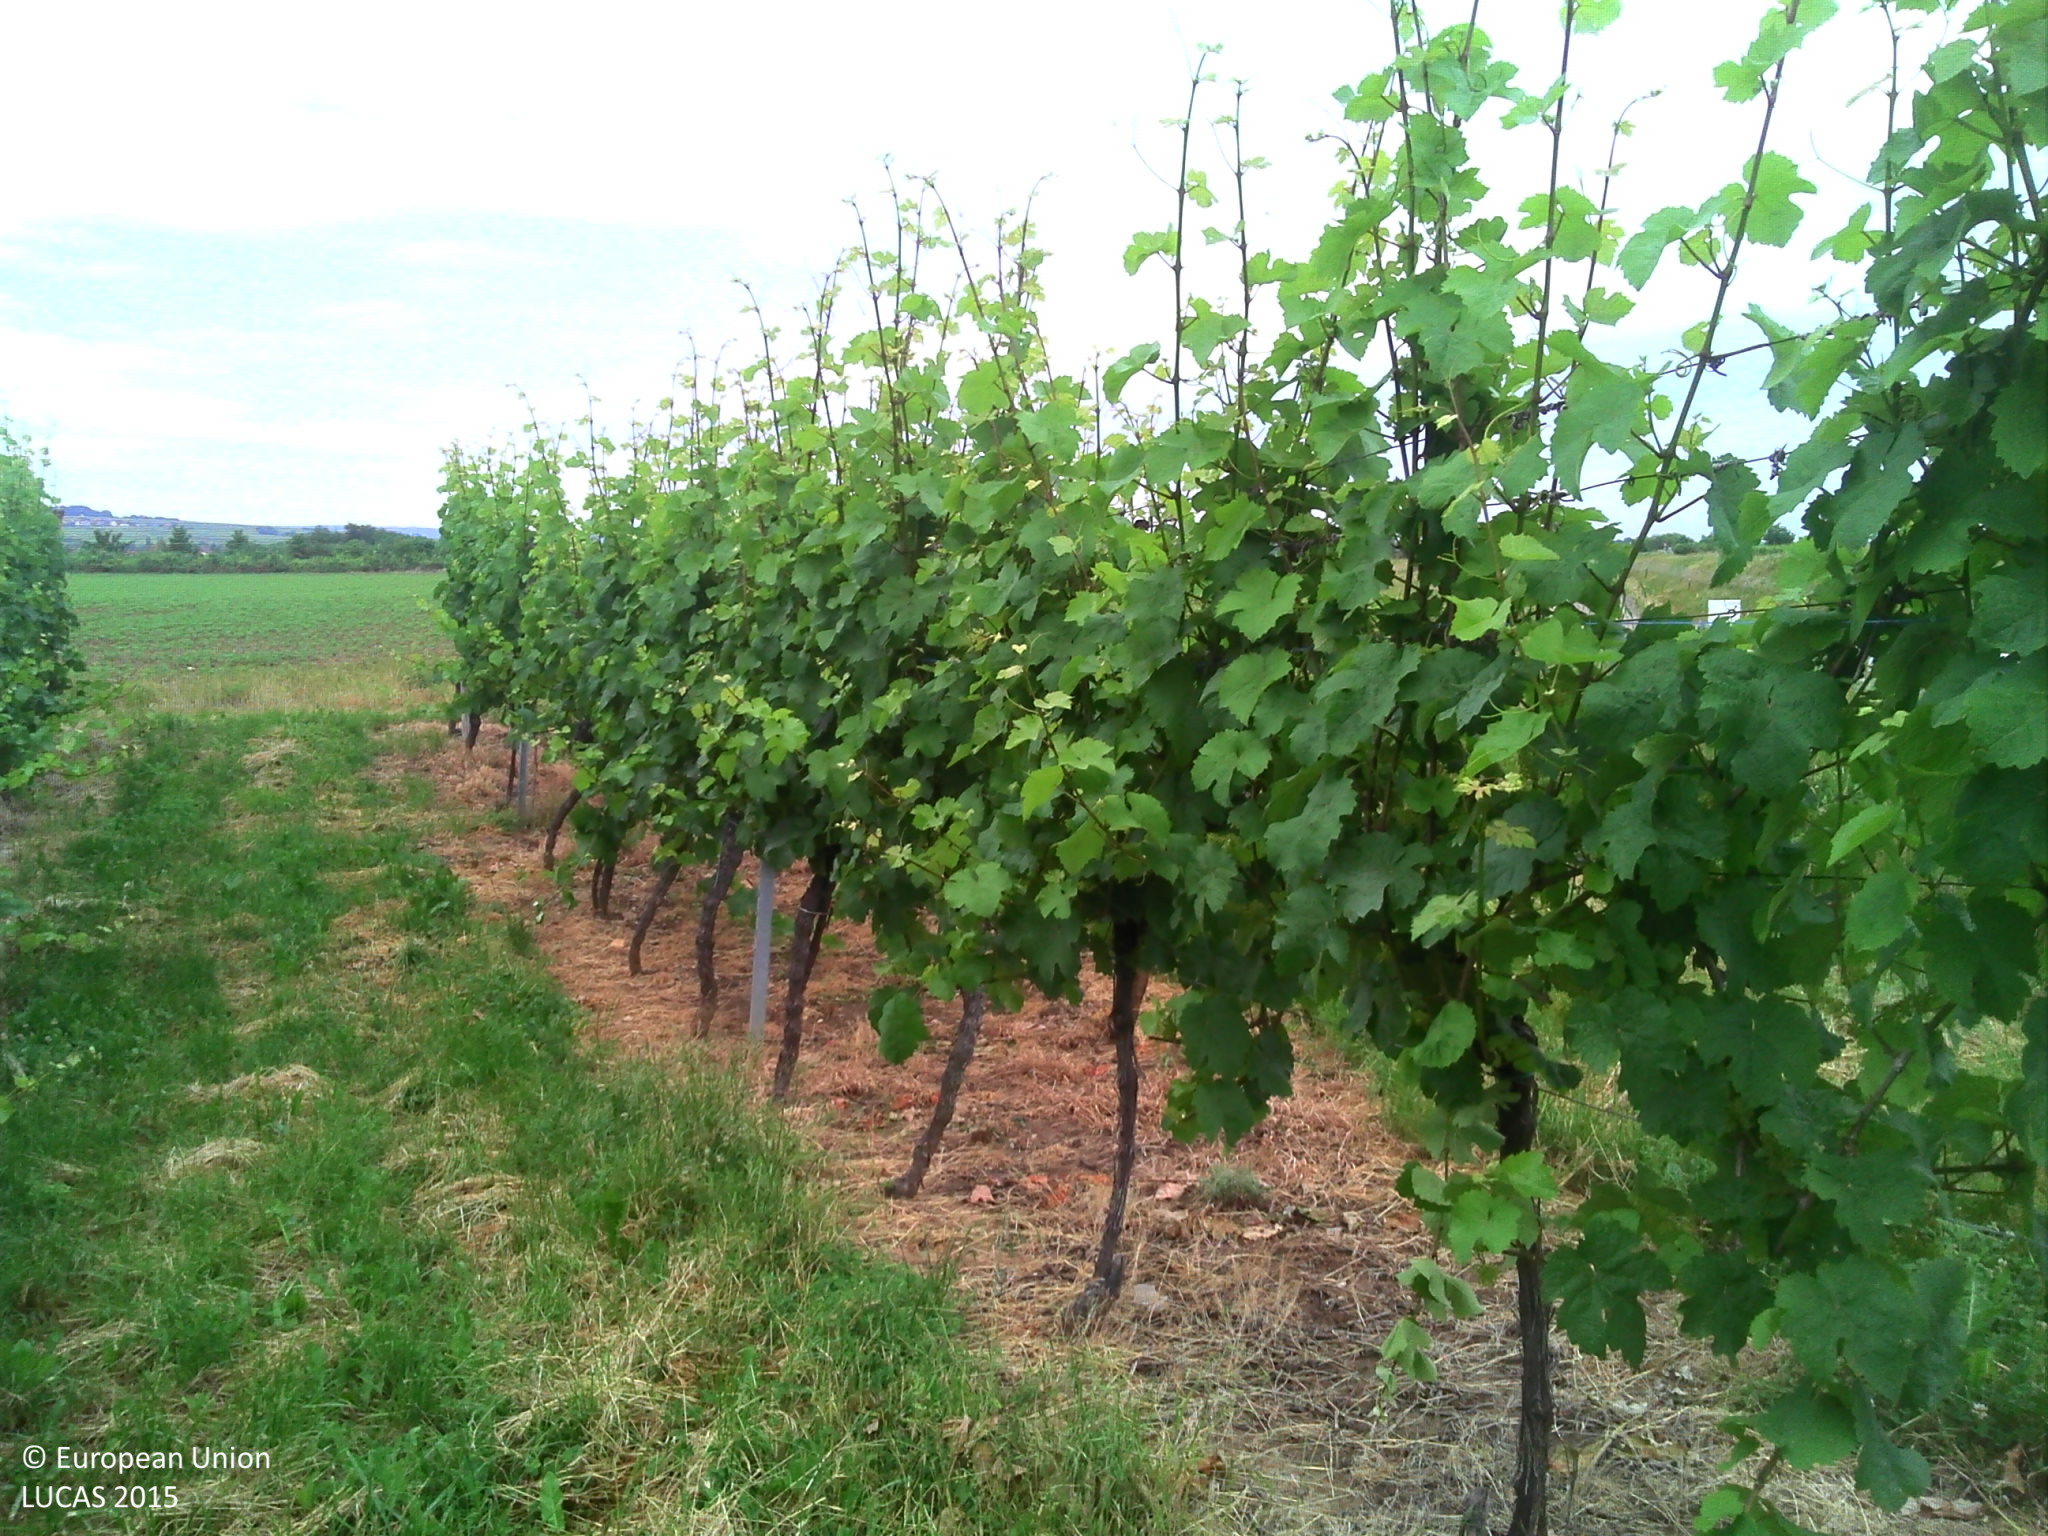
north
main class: Cropland
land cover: Vineyards
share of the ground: 50 - 75 %
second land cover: Grassland without tree/shrub cover
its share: 50 - 75 %
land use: Agriculture (excluding fallow land and kitchen gardens)
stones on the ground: < 10 %
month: June
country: FR
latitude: 48.3927
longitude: 7.4754
